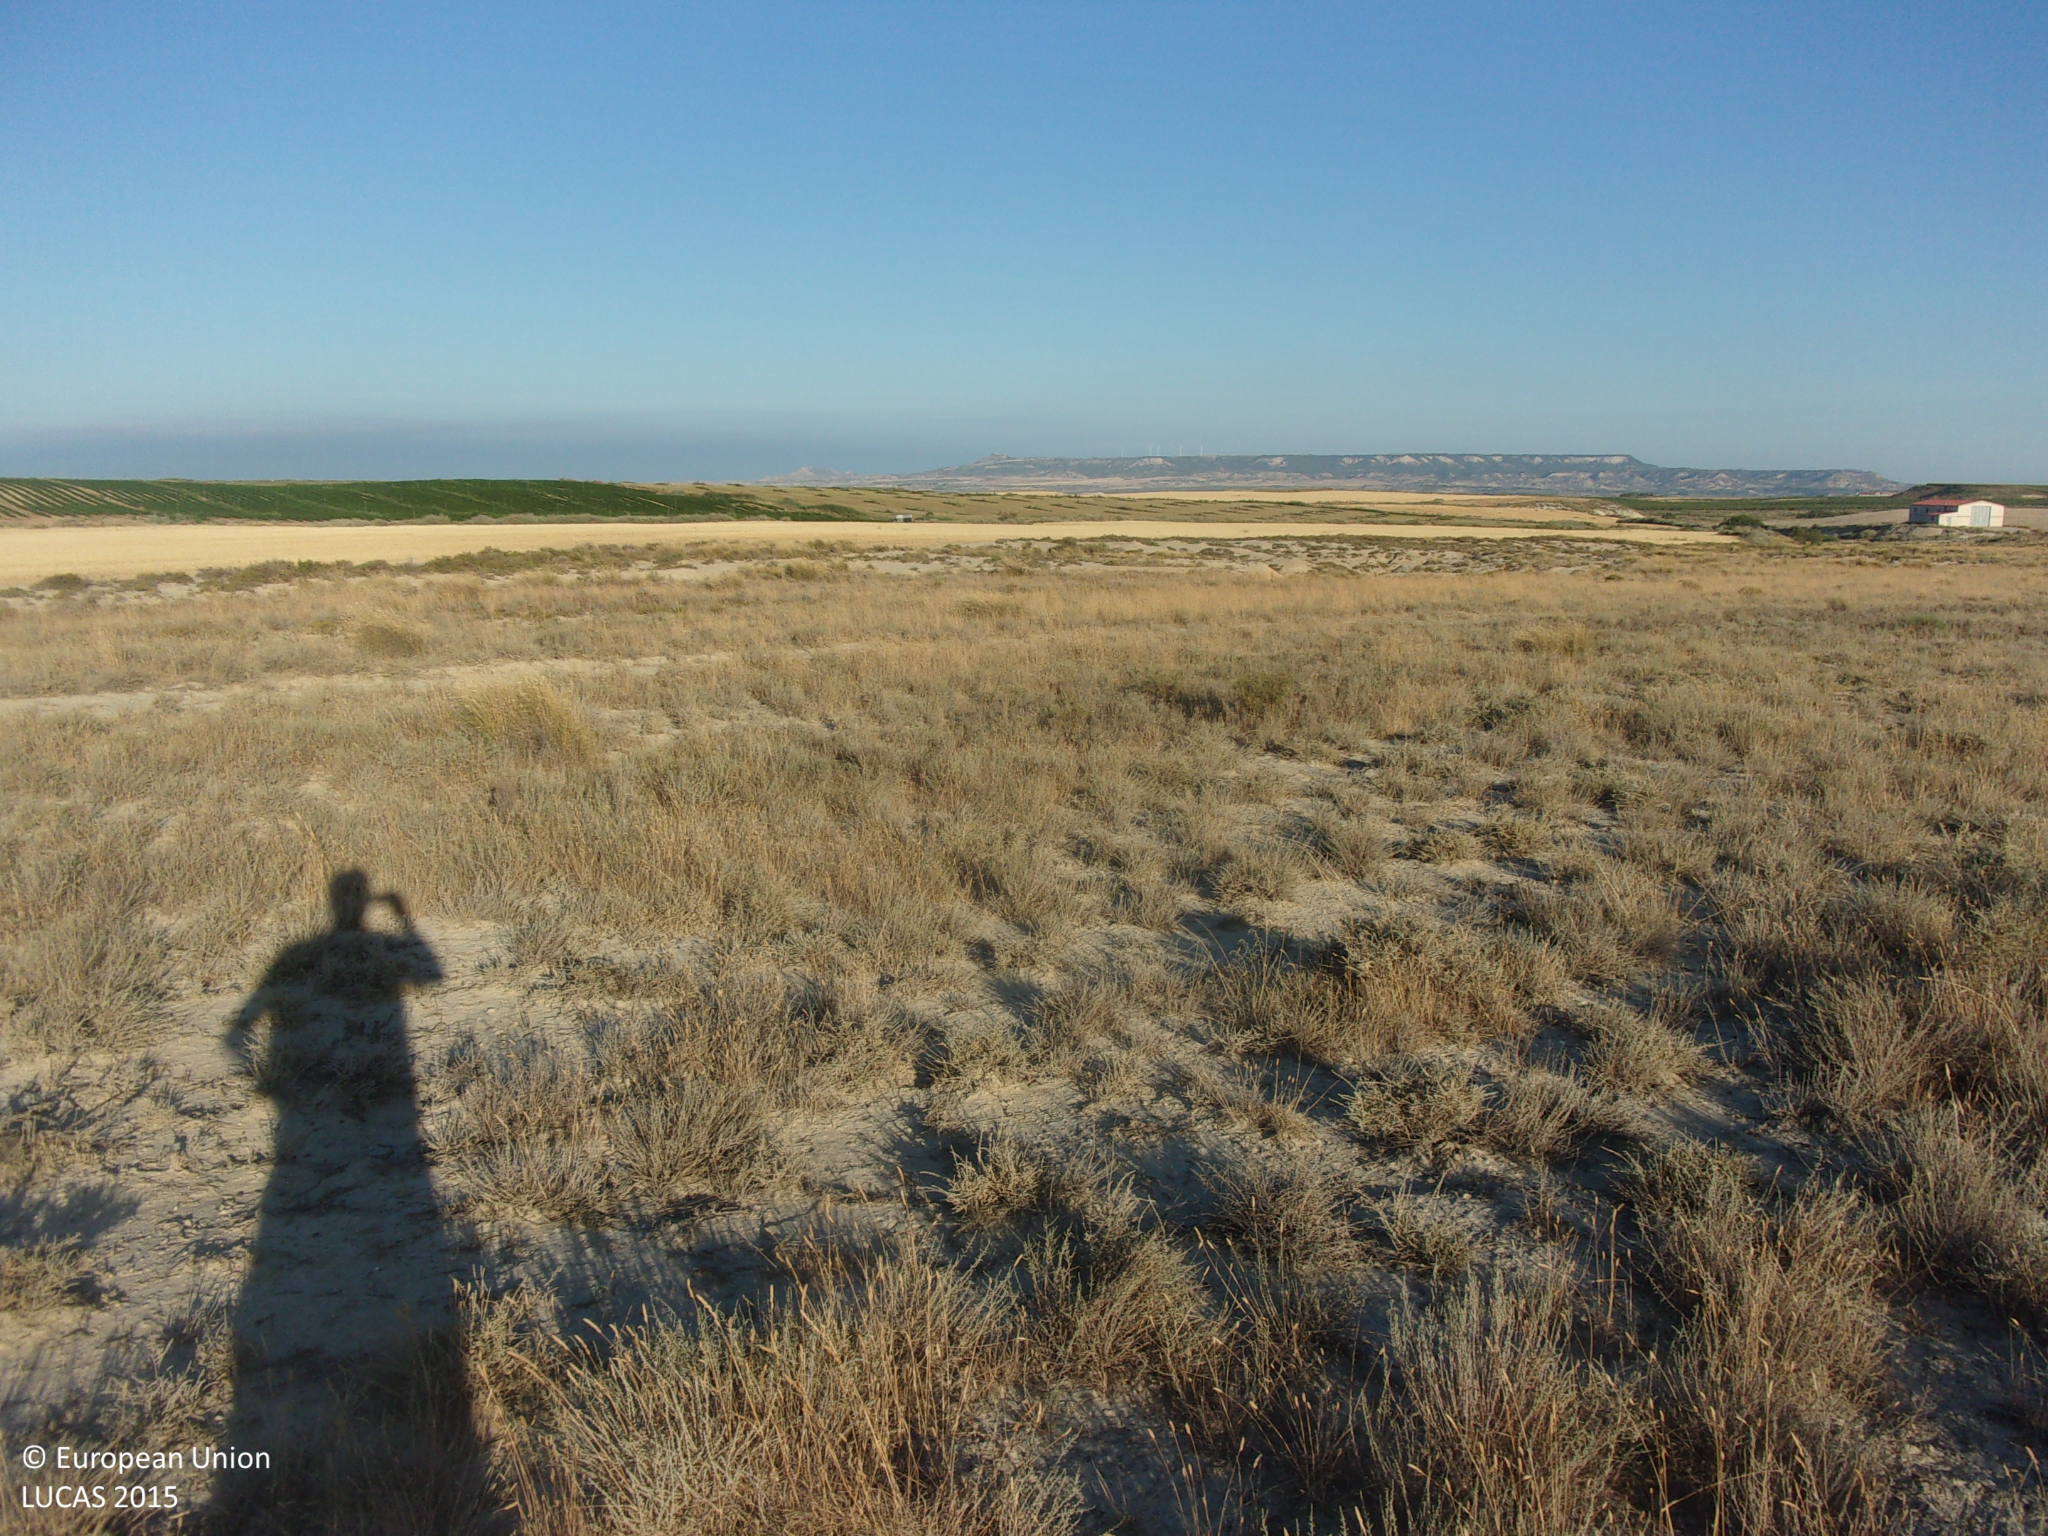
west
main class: Shrubland
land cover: Shrubland without tree cover
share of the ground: > 75 %
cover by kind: shrubs 80 %, herbaceous plants 10 %, consolidated bare surface 10 %
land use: Abandoned areas
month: July
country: ES
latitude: 42.0031
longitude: -1.1224
